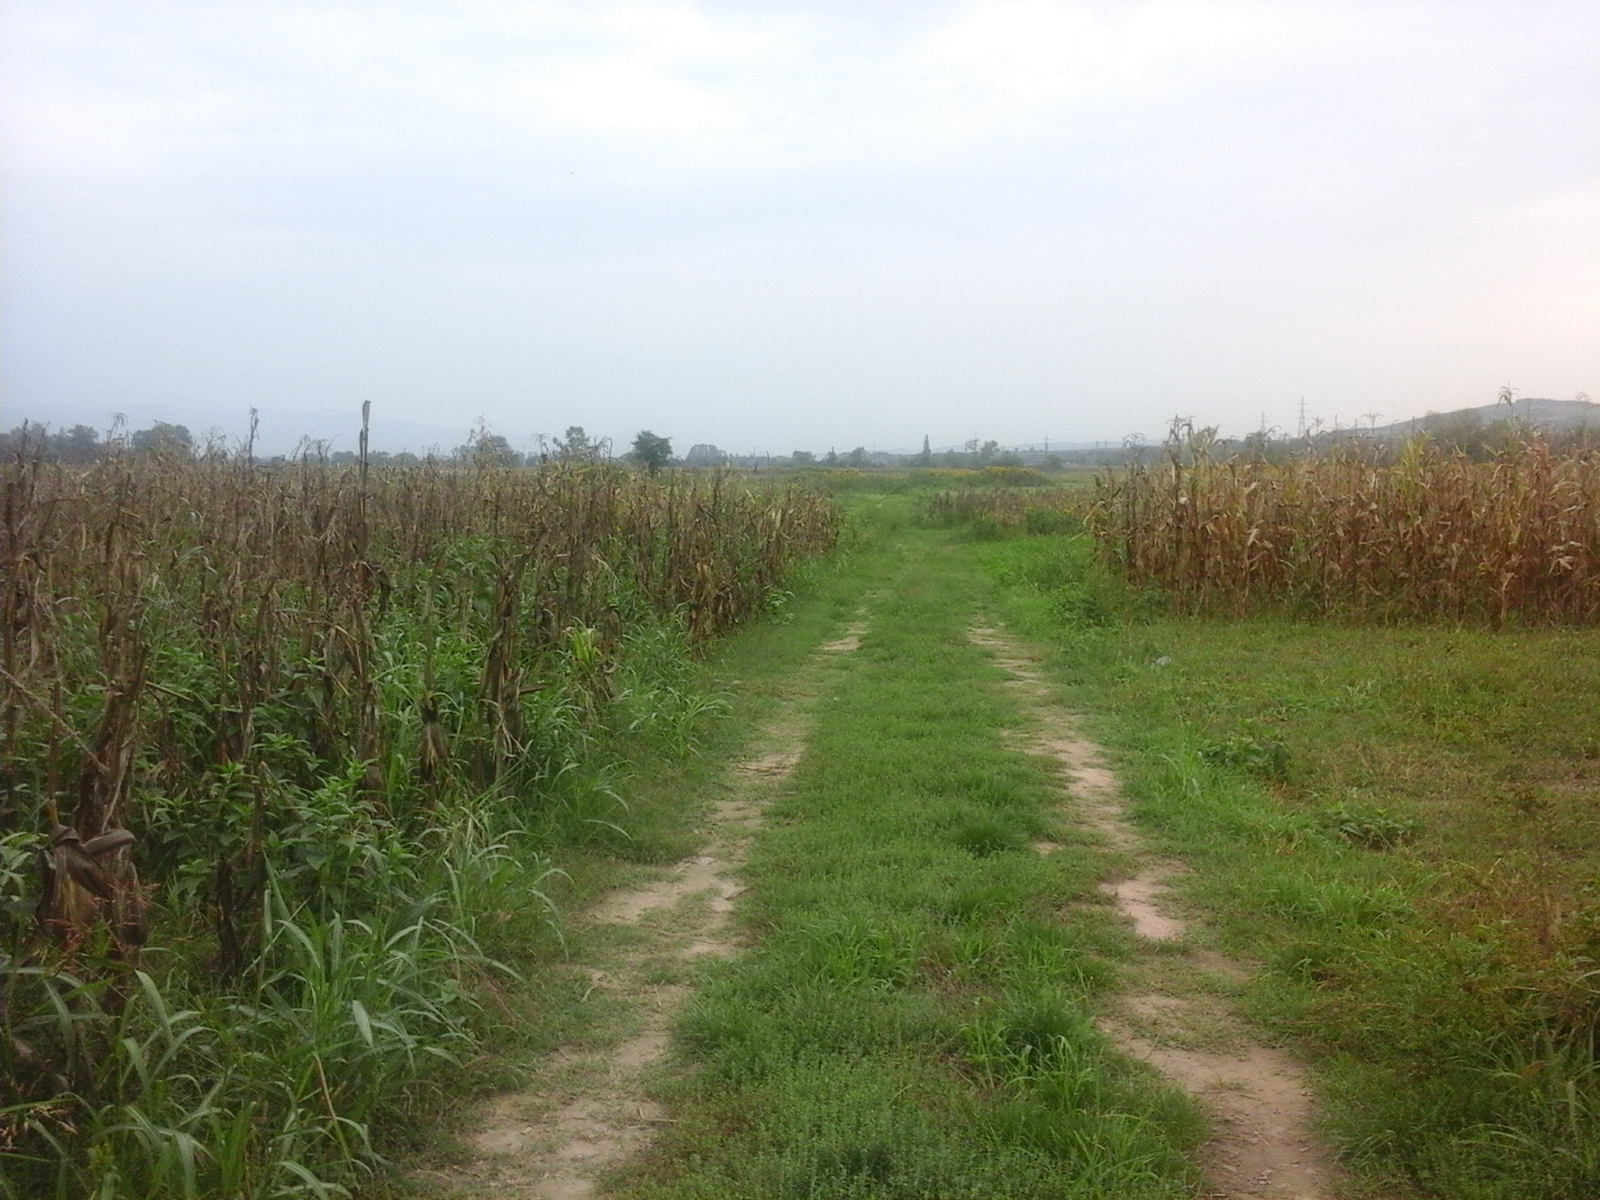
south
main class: Cropland
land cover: Maize
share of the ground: > 75 %
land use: Agriculture (excluding fallow land and kitchen gardens)
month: September
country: RO
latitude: 45.7722
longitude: 23.0045
